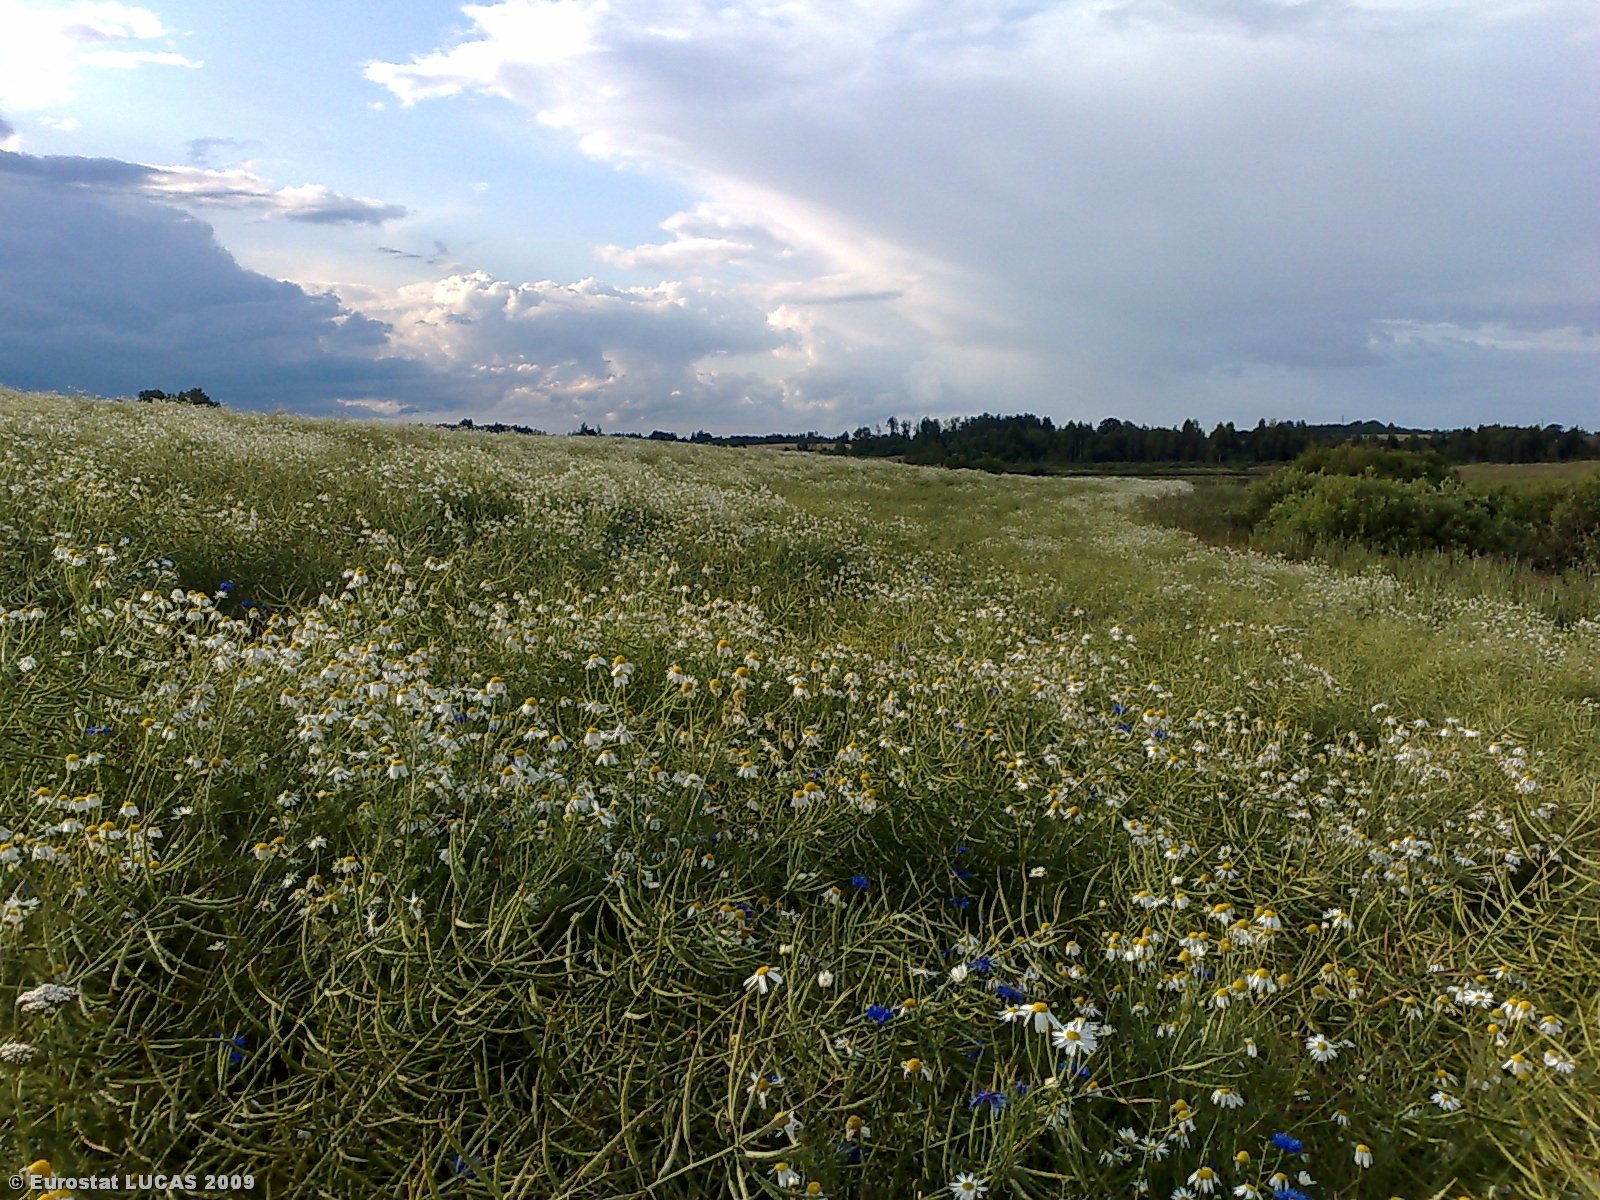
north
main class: Cropland
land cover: Rape and turnip rape
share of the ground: > 75 %
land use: Agriculture (excluding fallow land and kitchen gardens)
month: July
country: LT
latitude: 55.6500
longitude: 22.8267
